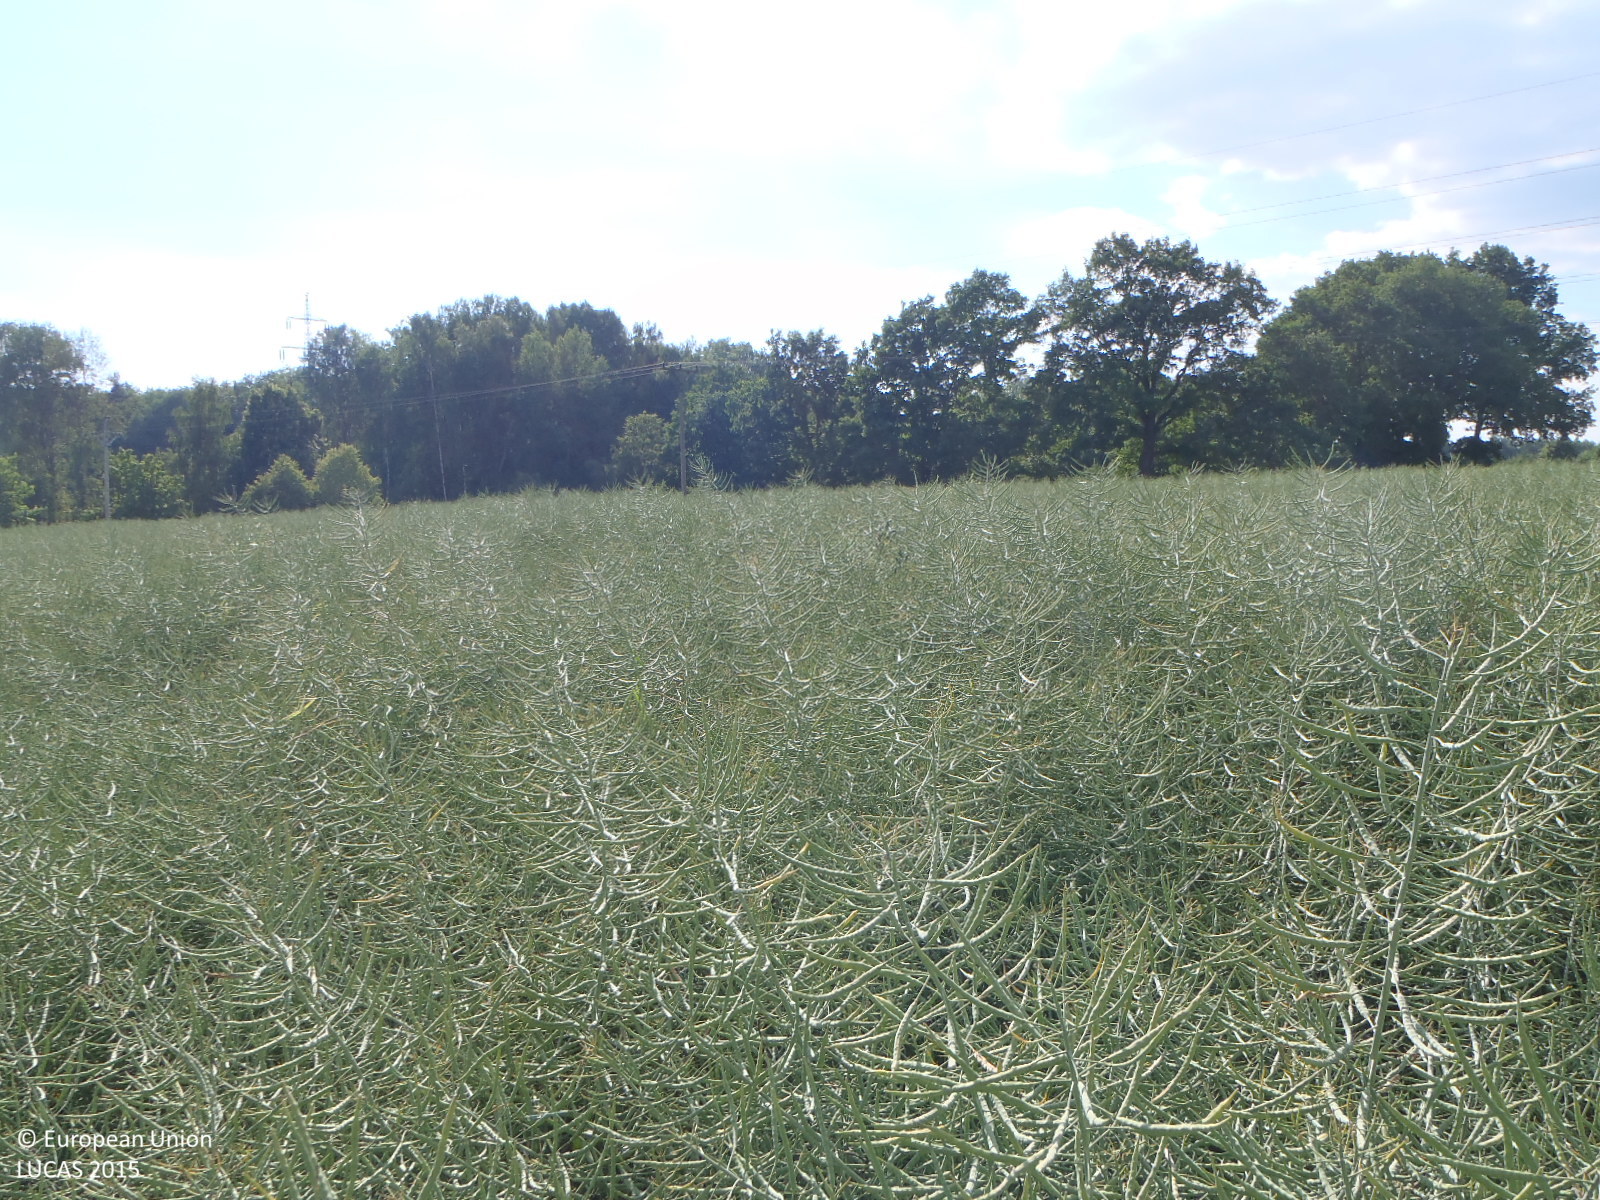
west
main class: Cropland
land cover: Rape and turnip rape
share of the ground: > 75 %
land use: Agriculture (excluding fallow land and kitchen gardens)
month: June
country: CZ
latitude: 49.0919
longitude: 14.3694
